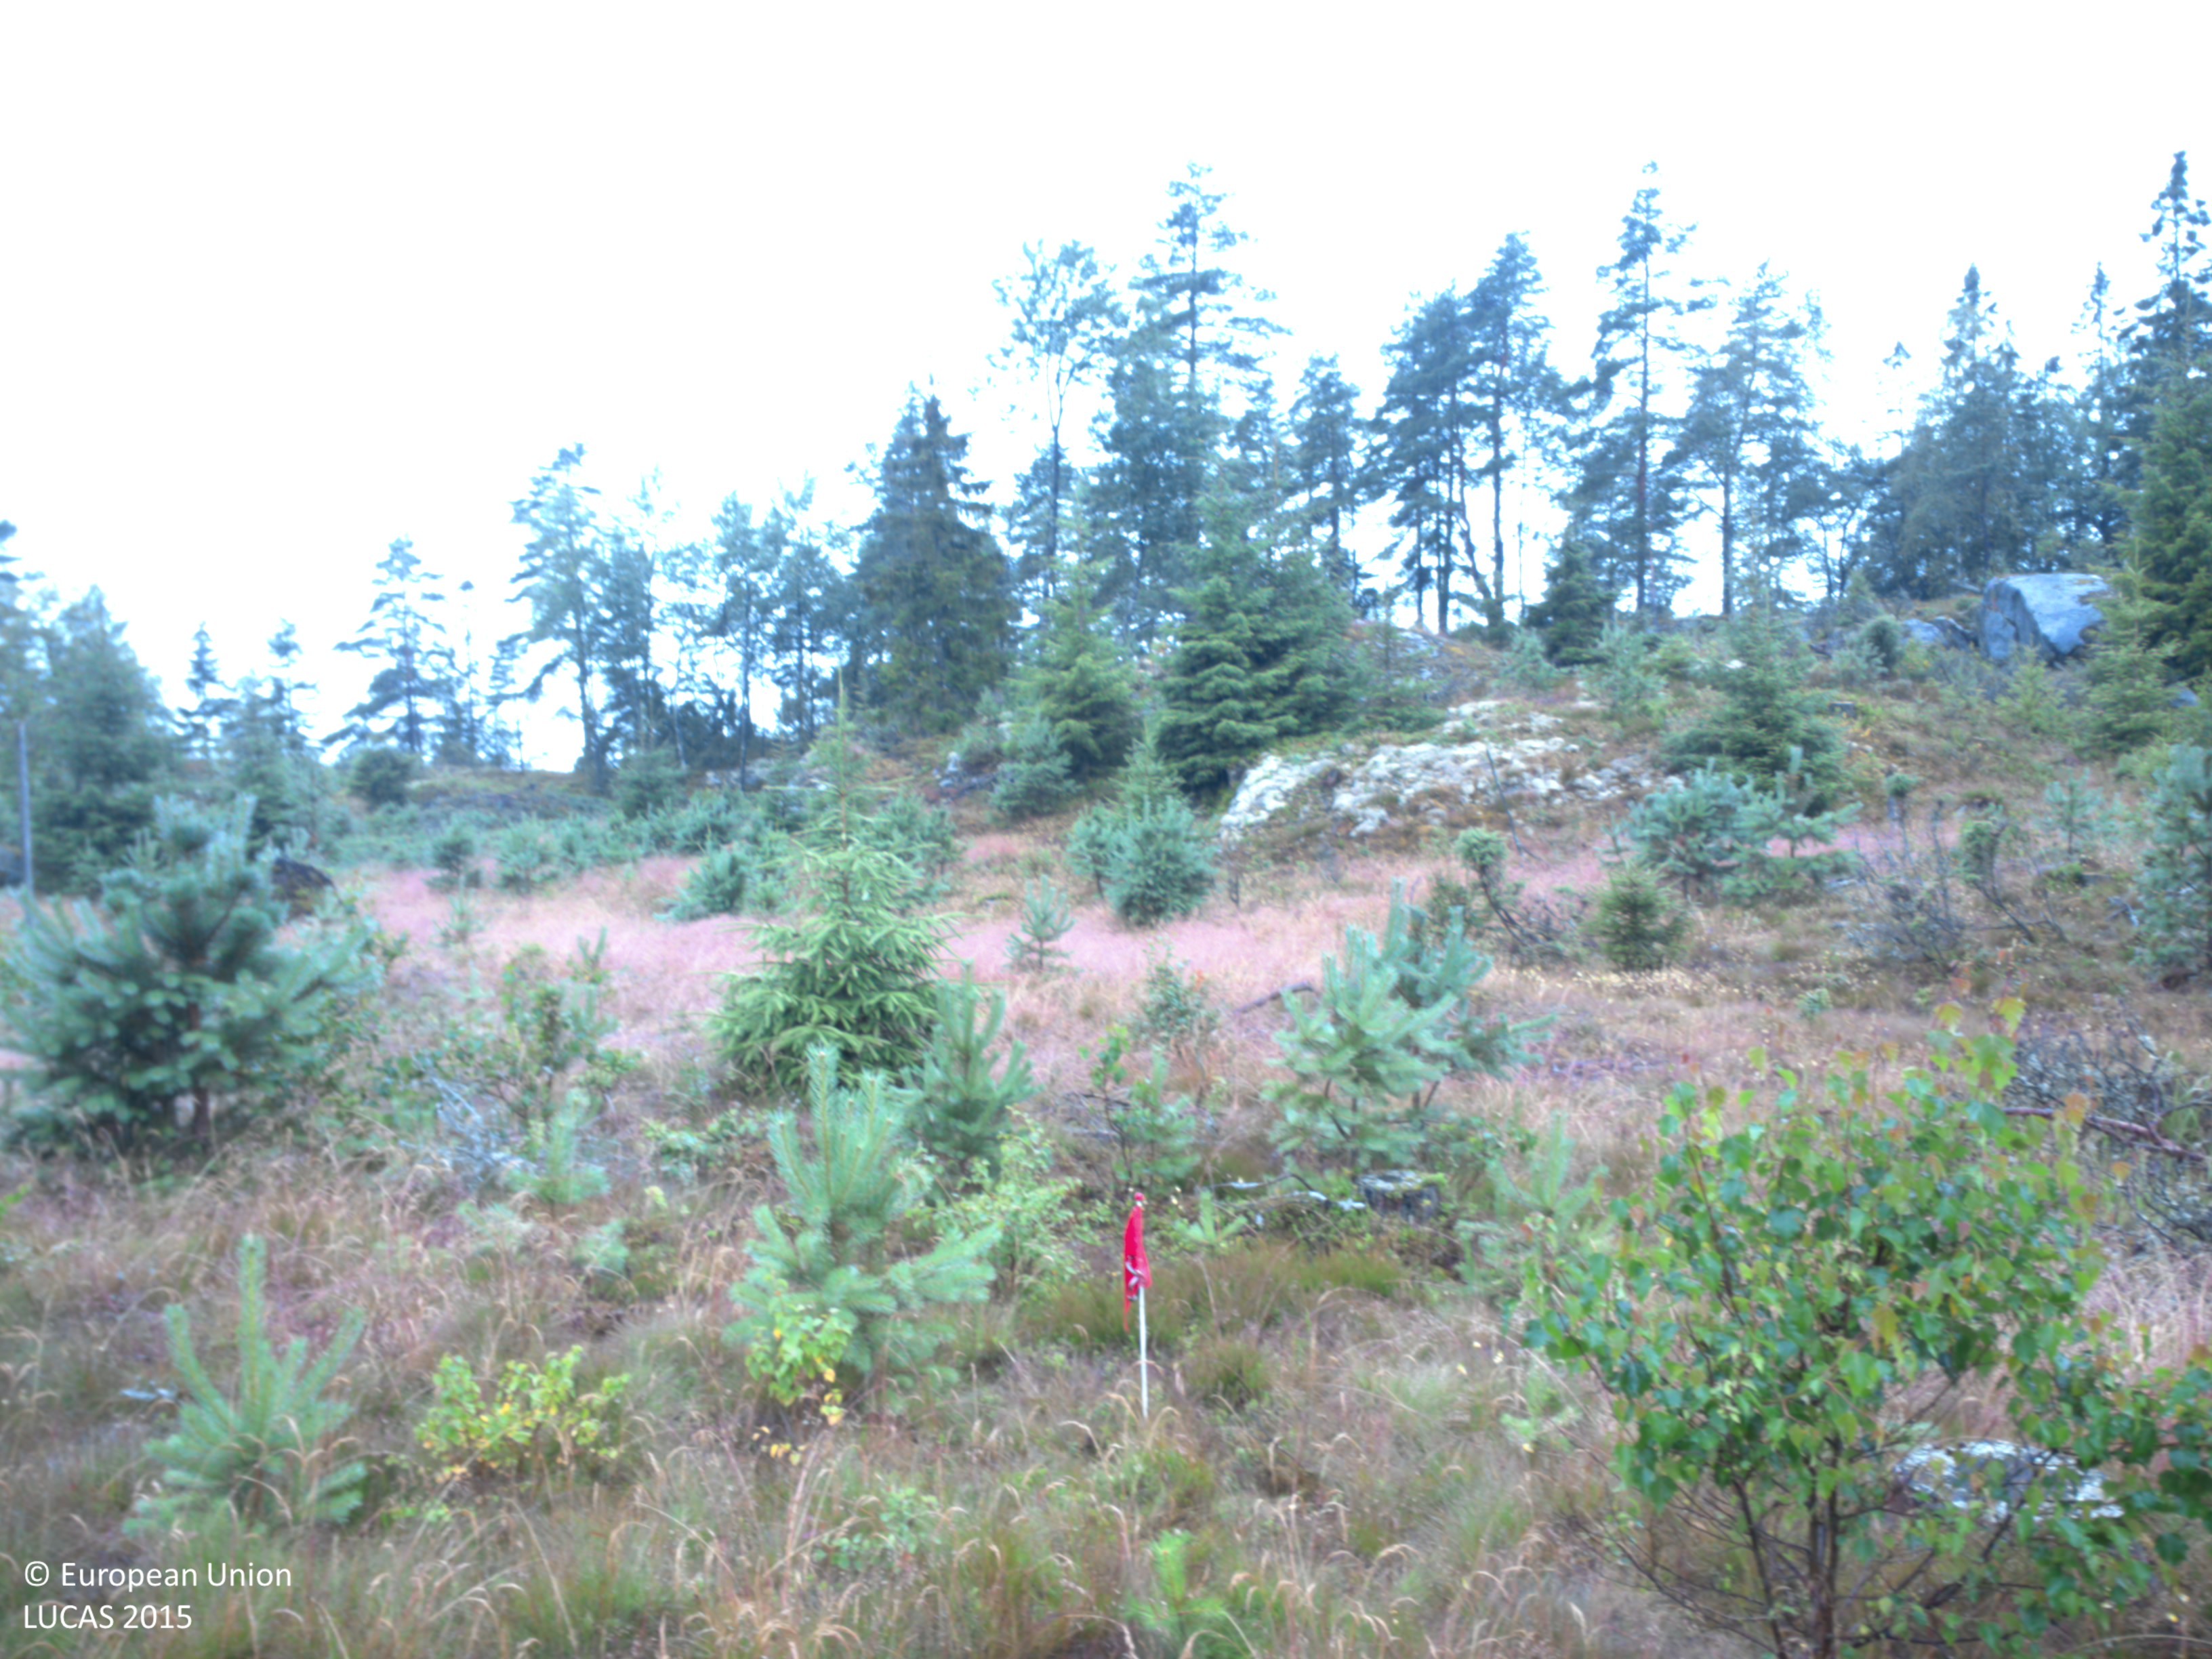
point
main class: Woodland
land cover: Pine dominated mixed woodland
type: boreal forest
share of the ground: 25 - 50 %
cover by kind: herbaceous plants 50 %, coniferous forest trees 30 %, broadleaved forest trees 20 %
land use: Forestry
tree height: < 5 m
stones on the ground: < 10 %
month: July
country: SE
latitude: 58.6773
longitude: 11.6348
